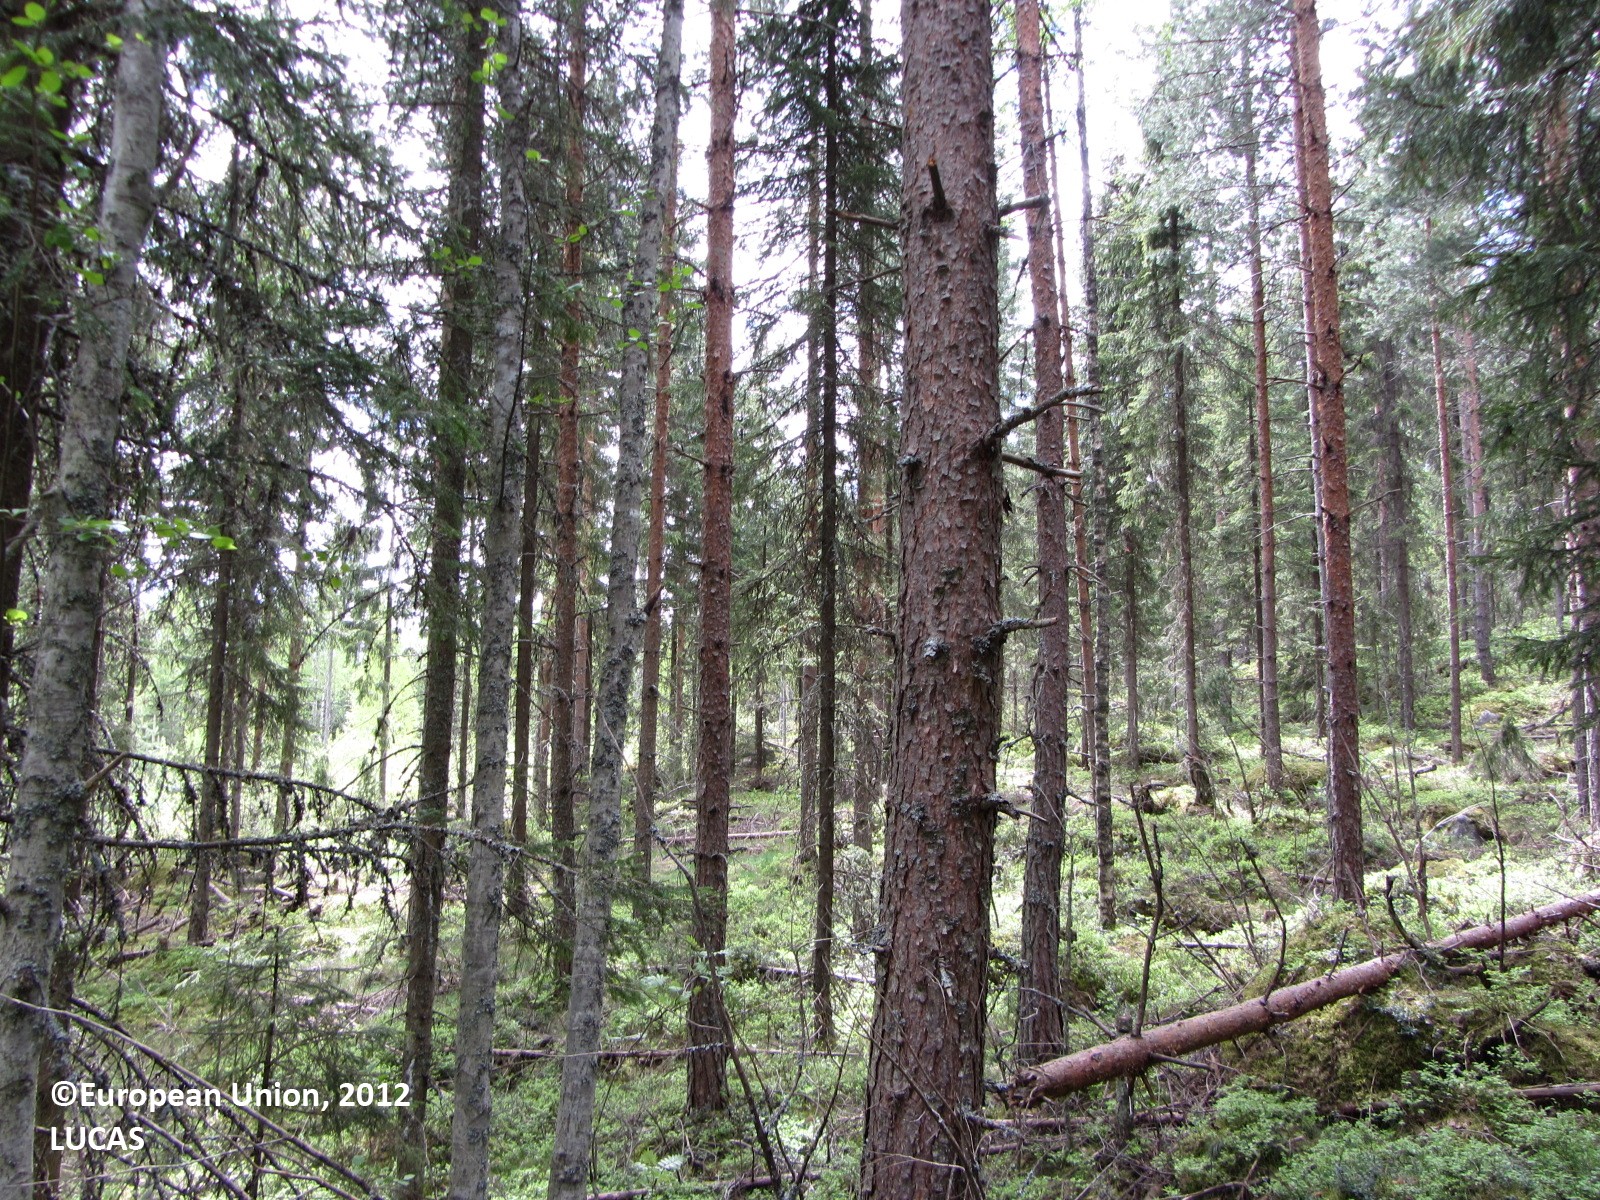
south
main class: Woodland
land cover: Pine dominated coniferous woodland
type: boreal forest
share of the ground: > 75 %
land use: Forestry
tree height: > 5 m
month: May
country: FI
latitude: 62.4636
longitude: 25.5270
